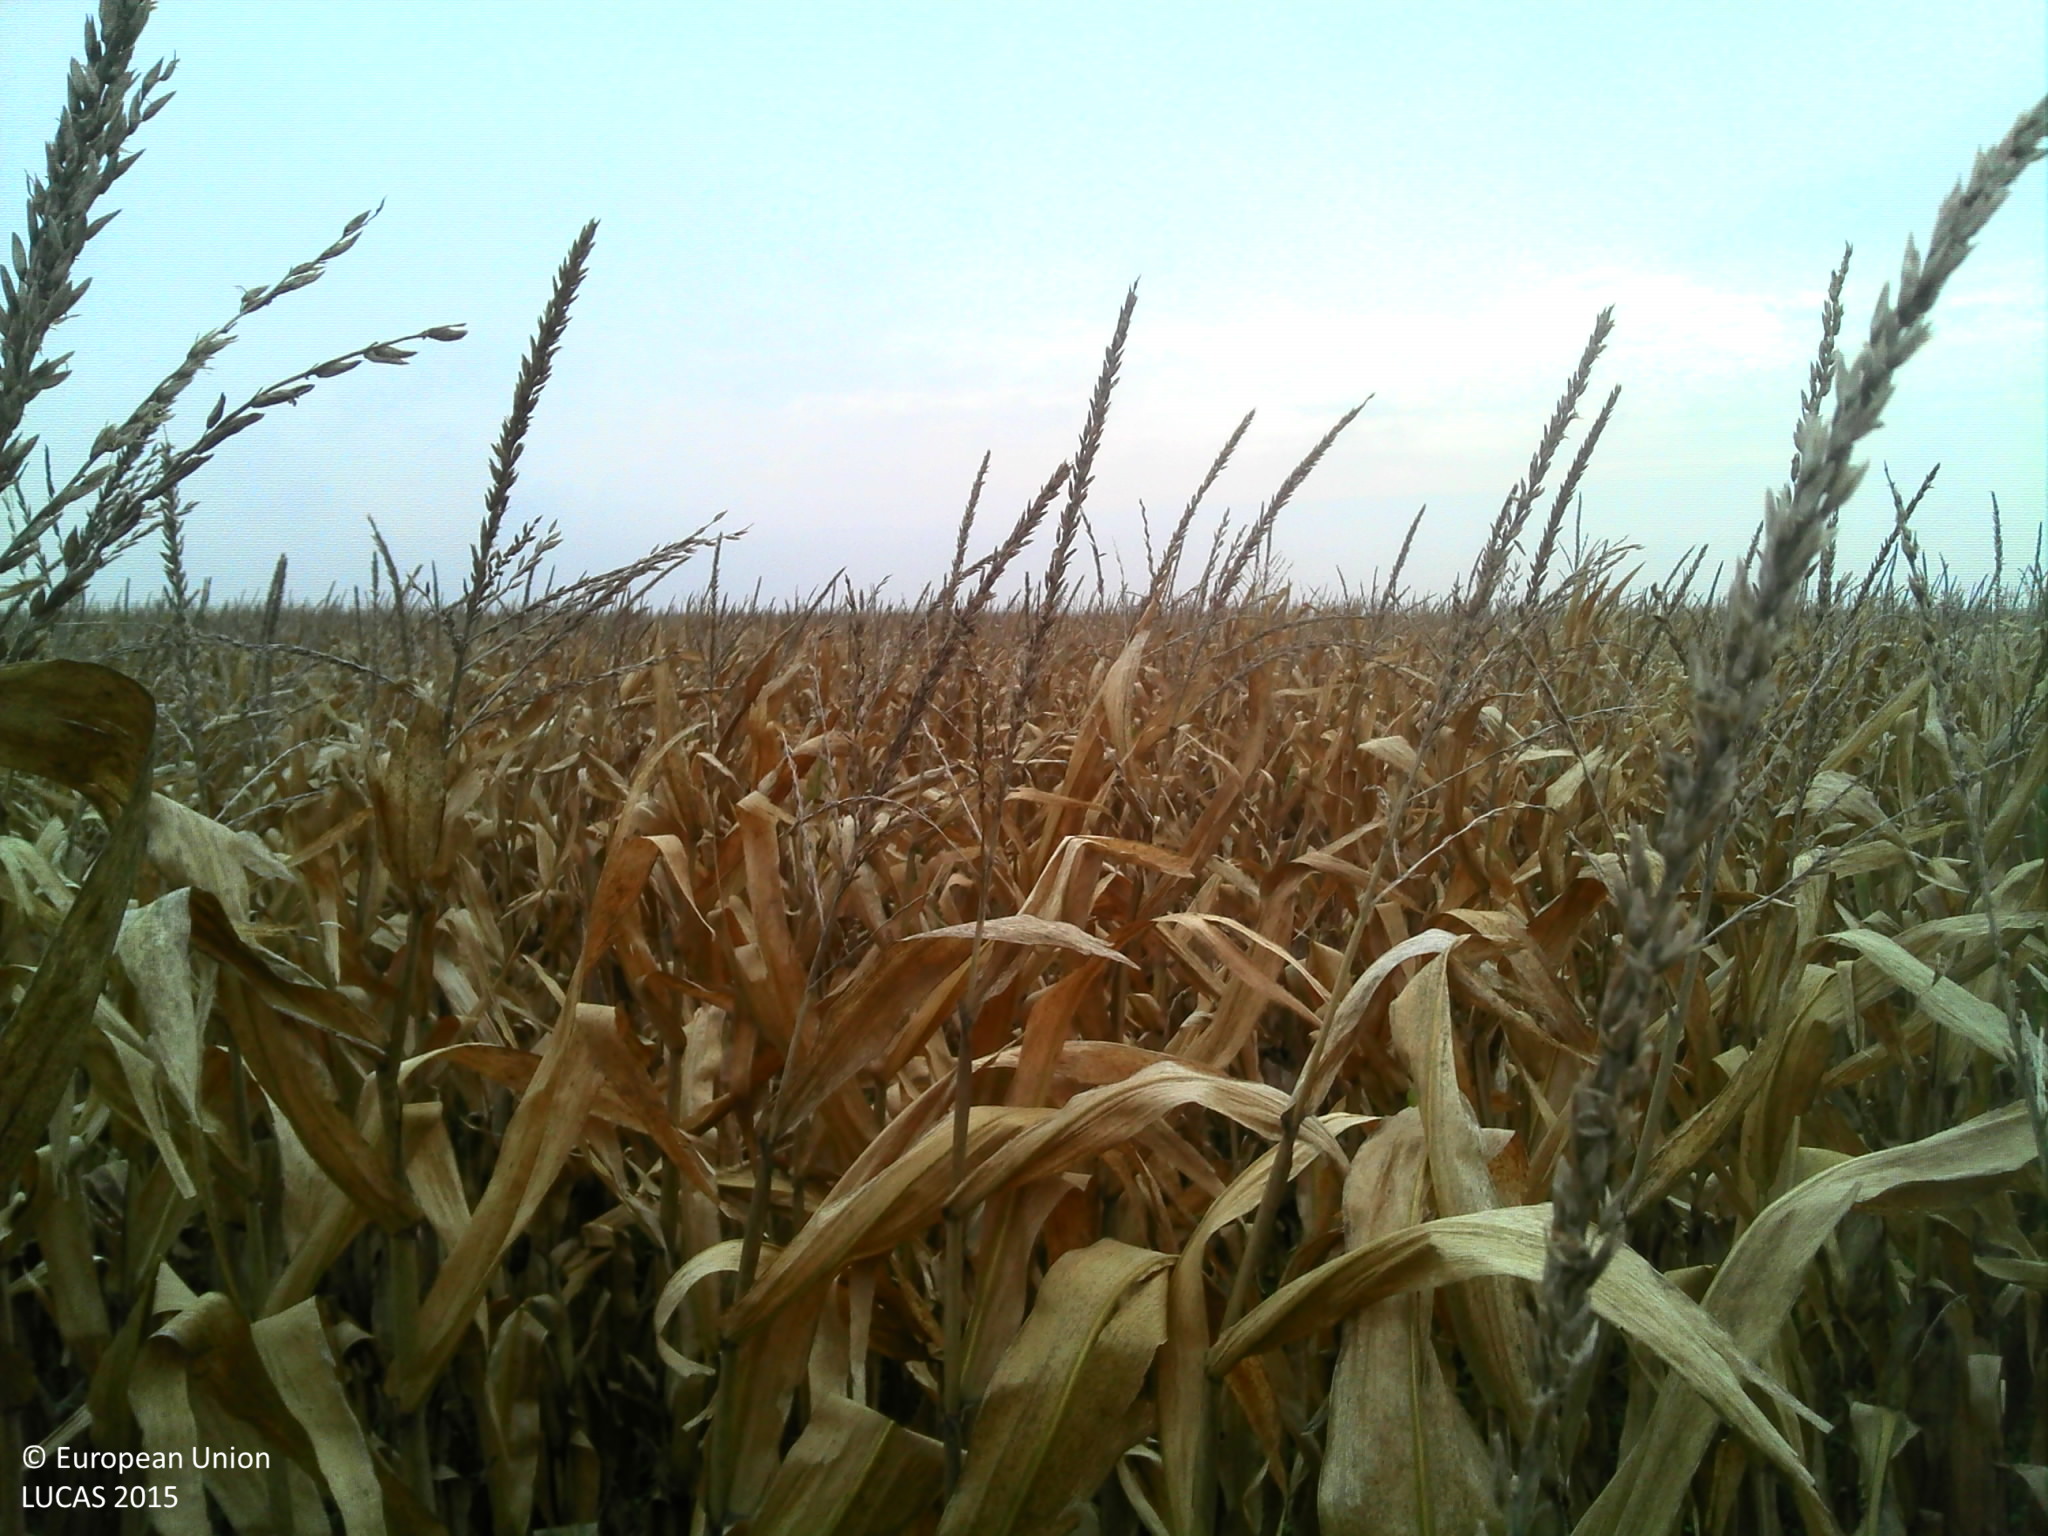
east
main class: Cropland
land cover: Maize
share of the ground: 25 - 50 %
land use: Agriculture (excluding fallow land and kitchen gardens)
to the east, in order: Maize
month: October
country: FR
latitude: 46.4536
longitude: -1.0069
